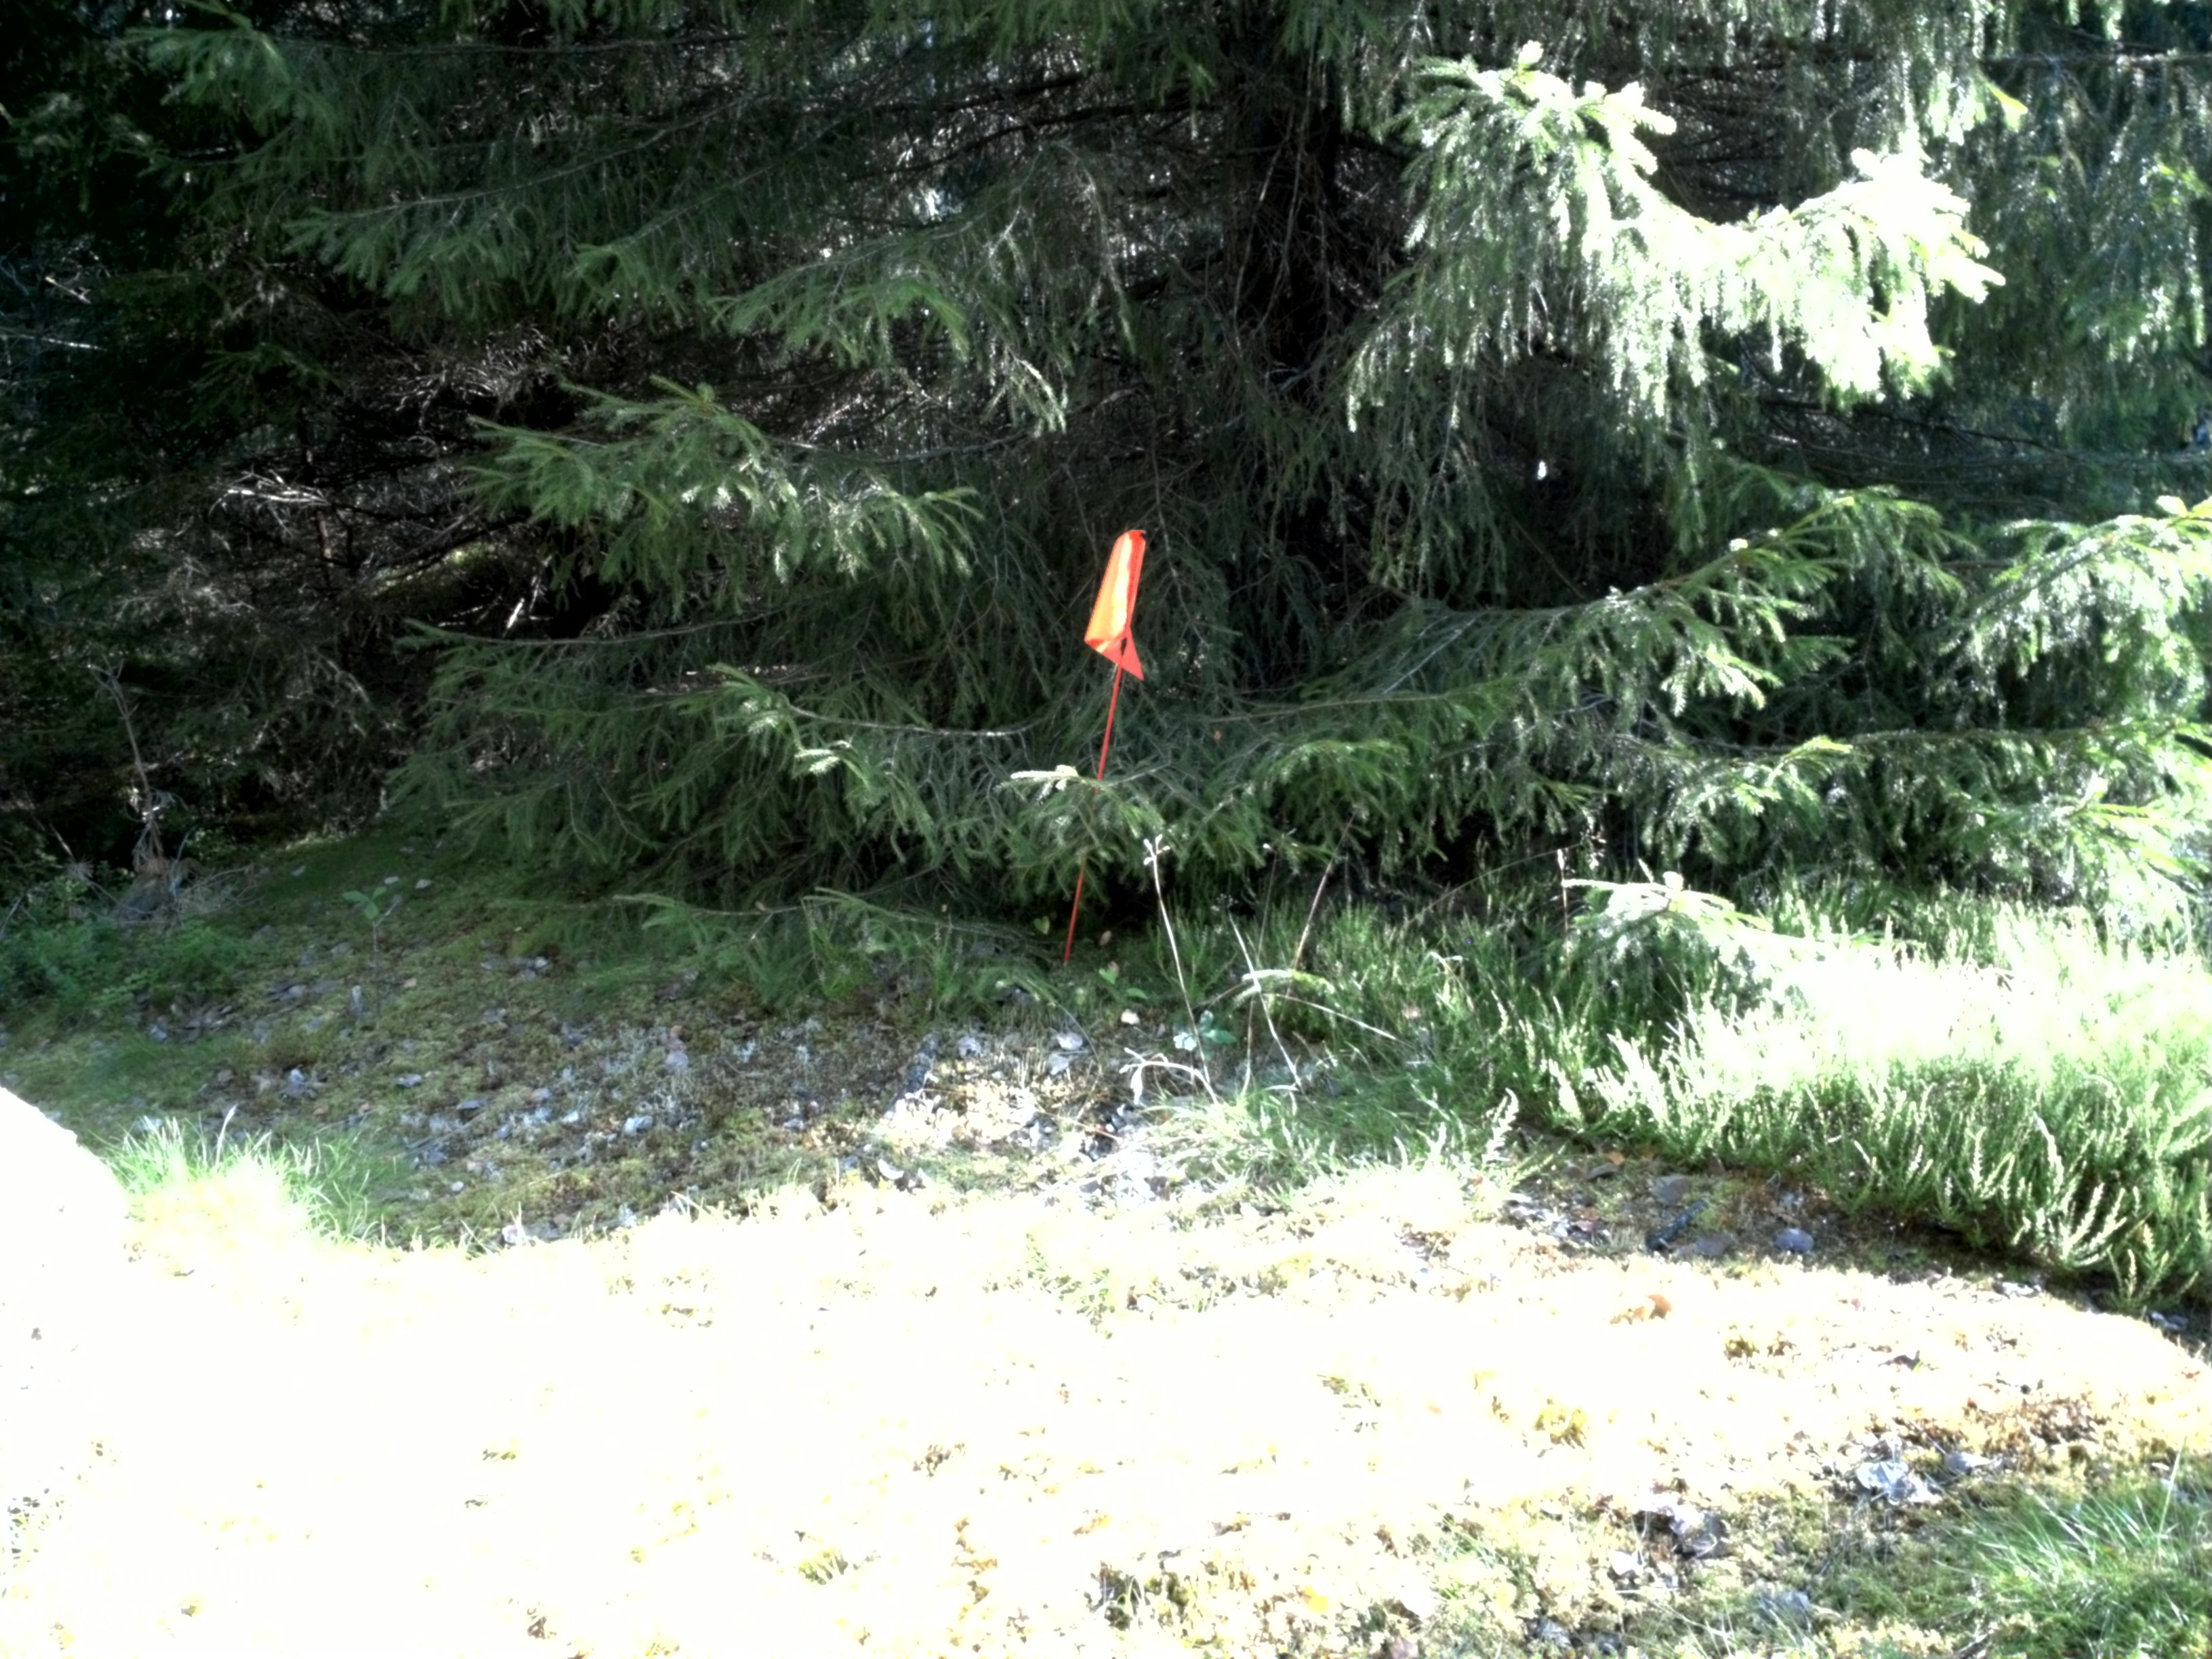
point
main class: Woodland
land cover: Spruce dominated mixed woodland
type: boreal forest
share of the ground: 50 - 75 %
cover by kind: coniferous forest trees 45 %, broadleaved forest trees 30 %, lichens and mosses 15 %, herbaceous plants 10 %
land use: Forestry
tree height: > 5 m
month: August
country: SE
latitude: 59.7669
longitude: 17.7762
